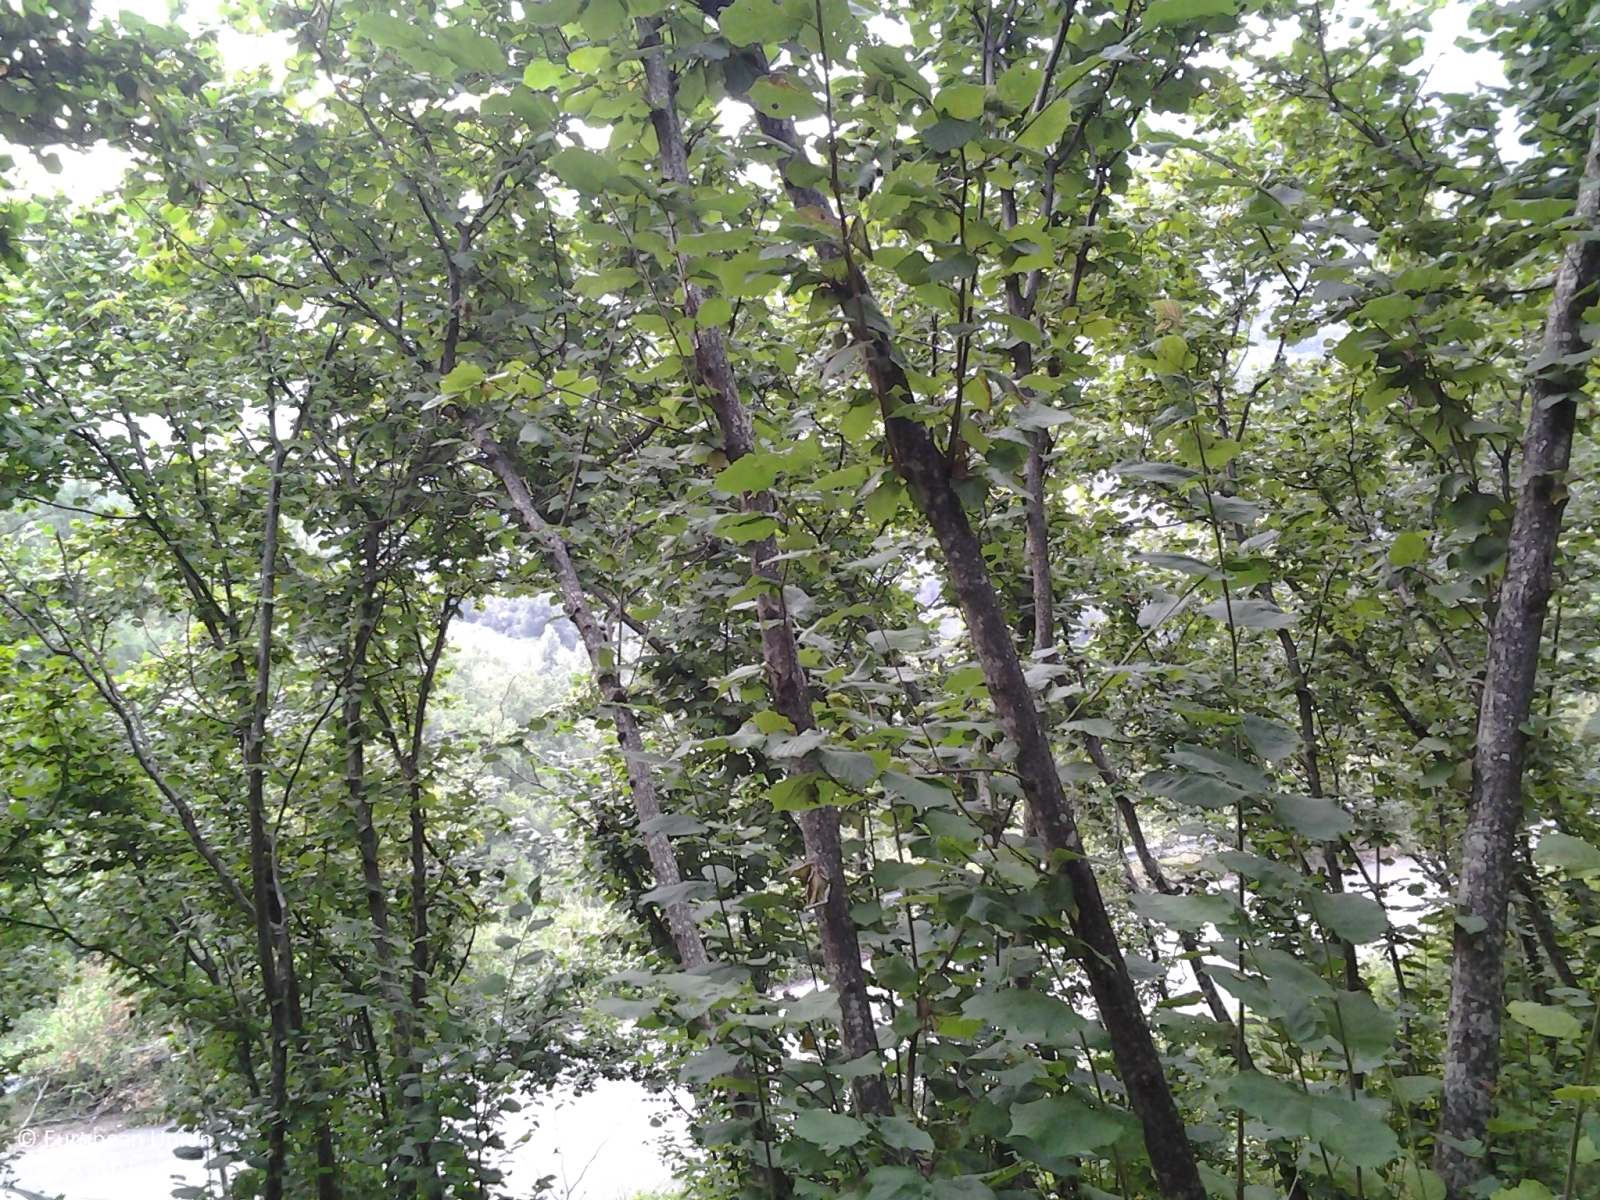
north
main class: Cropland
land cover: Nuts trees
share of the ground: > 75 %
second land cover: Spontaneously vegetated surfaces
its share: > 75 %
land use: Agriculture (excluding fallow land and kitchen gardens)
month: July
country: IT
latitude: 38.0585
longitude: 14.8797
